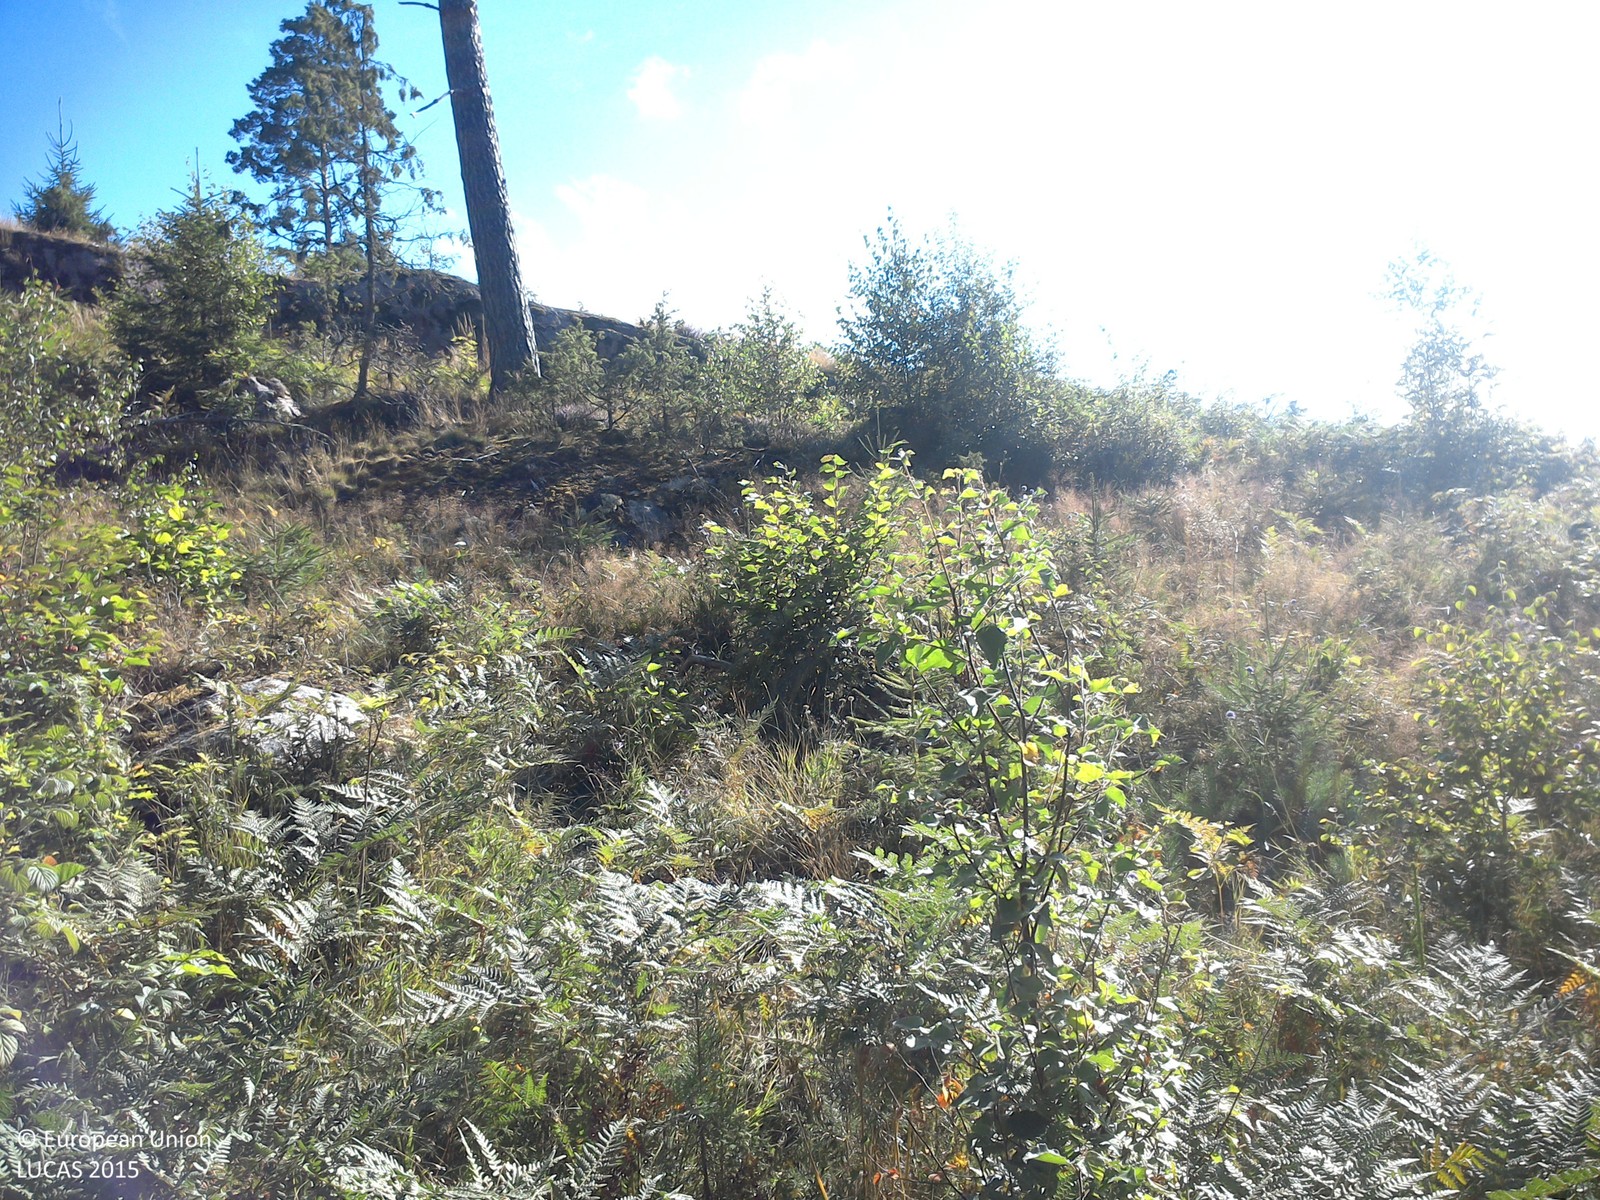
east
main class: Shrubland
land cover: Shrubland with sparse tree cover
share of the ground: 50 - 75 %
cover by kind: shrubs 55 %, herbaceous plants 40 %, broadleaved forest trees 5 %
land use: Forestry
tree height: < 5 m
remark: Clear cut
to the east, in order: Shrubland with sparse tree cover; Broadleaved woodland; Artificial constructions in urban areas; Grassland without tree/shrub cover; Pine dominated mixed woodland; Spruce dominated coniferous woodland; Ditches and canals; Broadleaved woodland; Paved roads, cycling and walking lanes
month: August
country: SE
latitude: 58.0390
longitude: 15.3984
